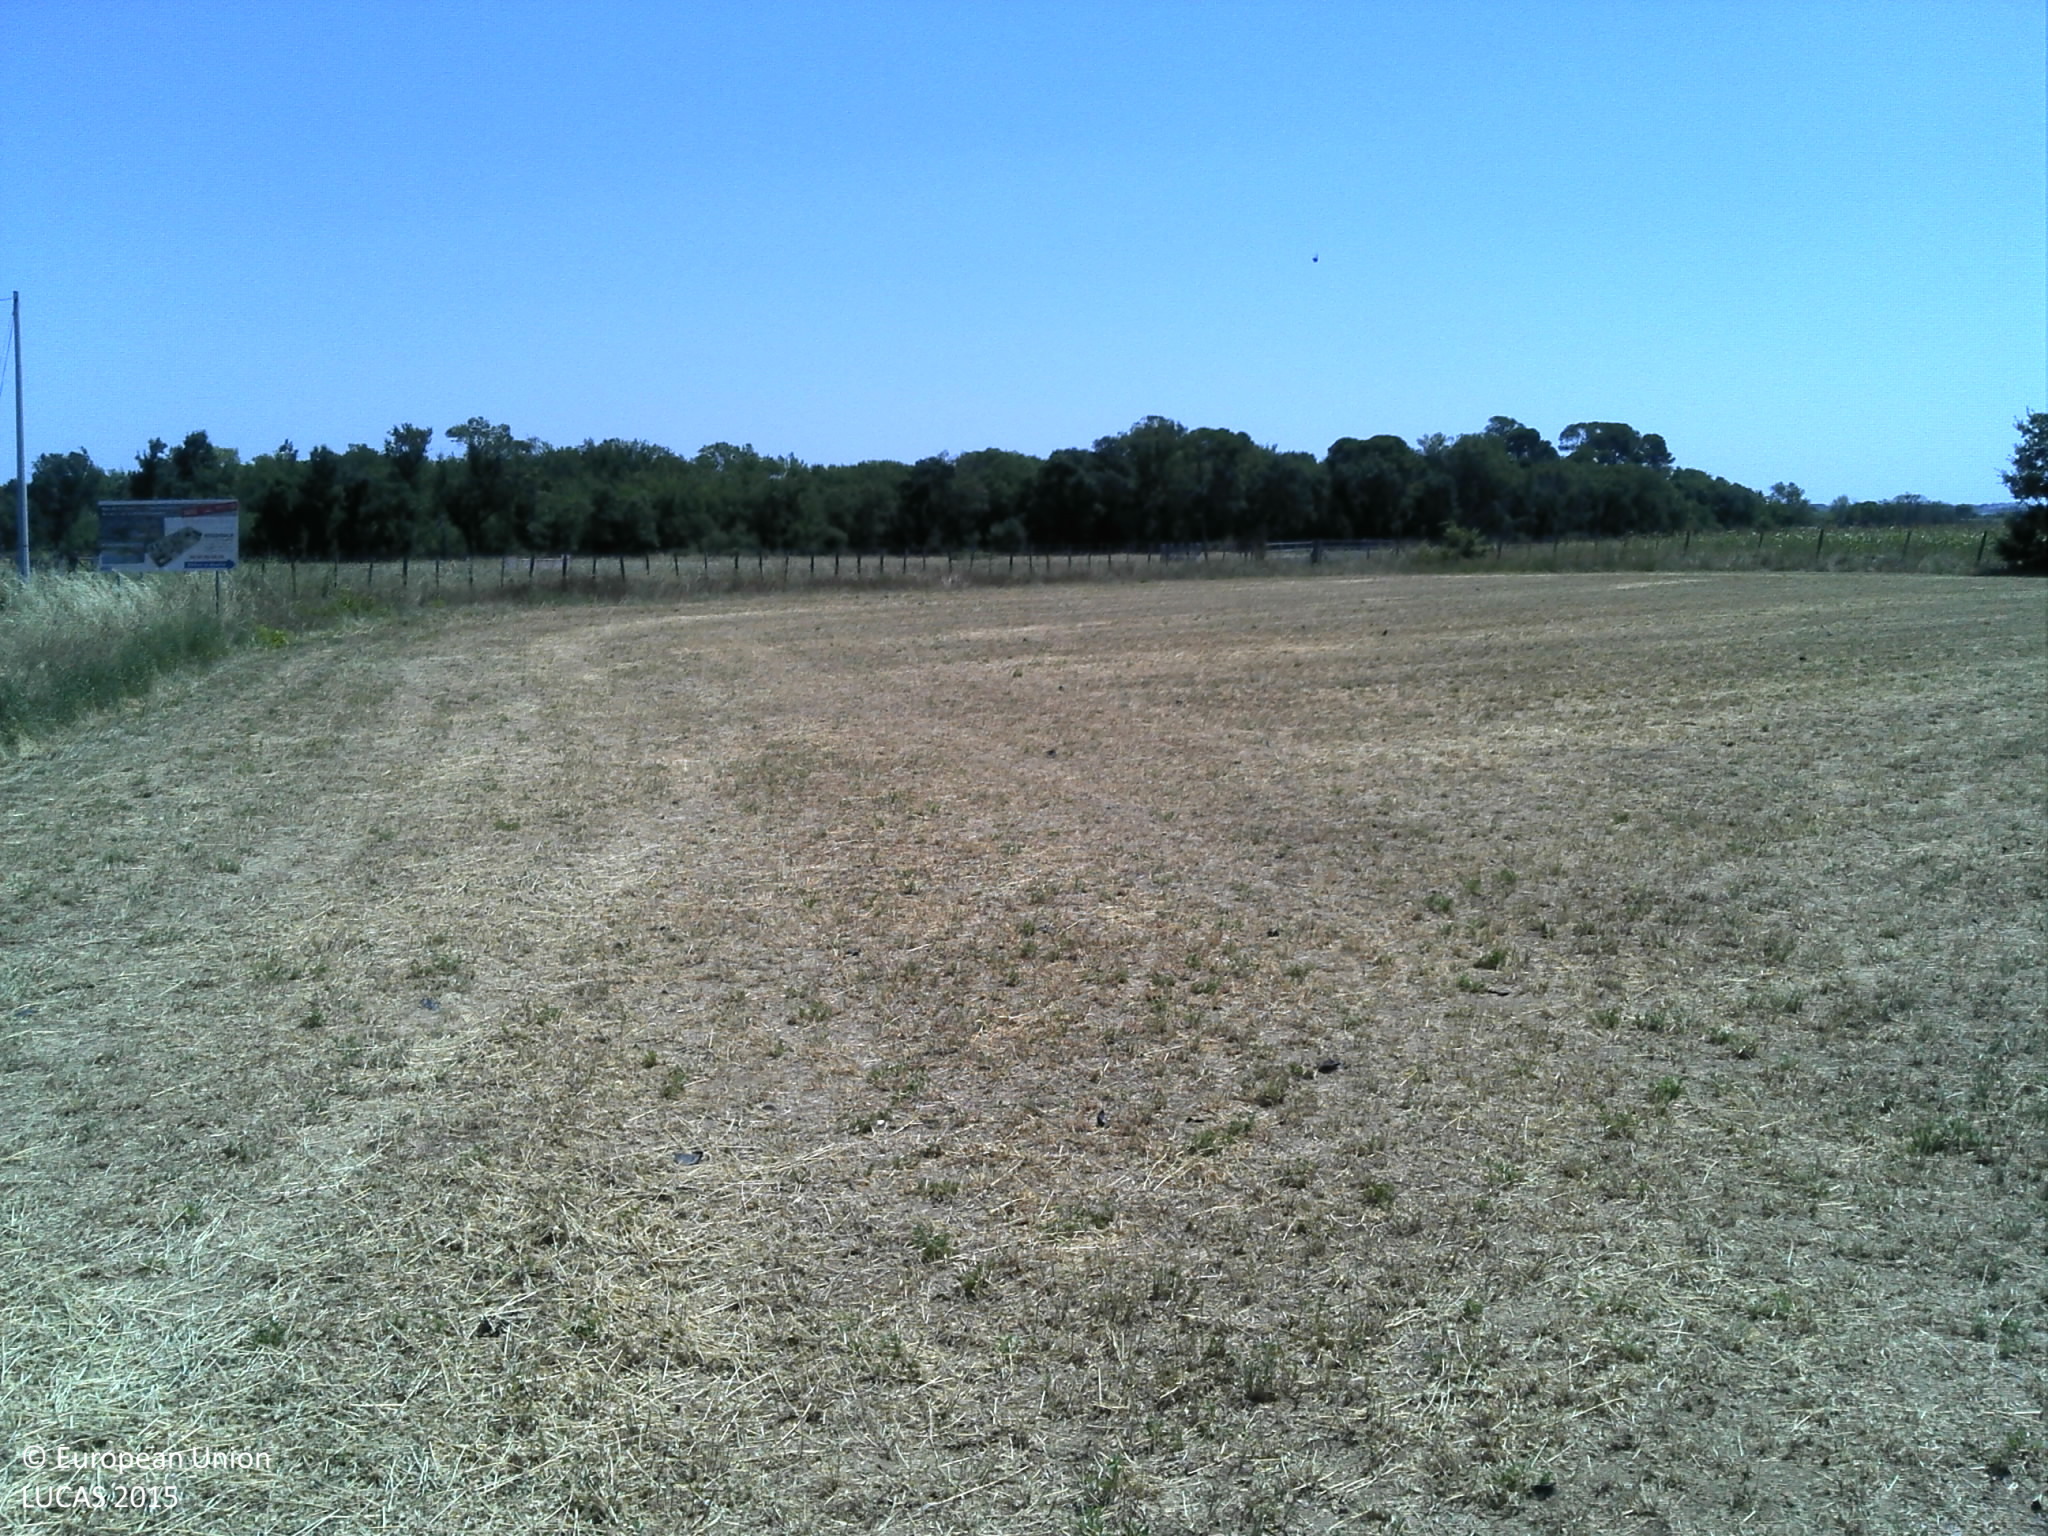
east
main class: Cropland
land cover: Temporary grasslands
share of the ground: > 75 %
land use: Agriculture (excluding fallow land and kitchen gardens)
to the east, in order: Temporary grasslands; Grassland without tree/shrub cover; Fences; Grassland without tree/shrub cover; Fences; Lines of trees; Ditches and canals; Fences; Broadleaved woodland
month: July
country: FR
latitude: 43.5579
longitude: 3.9312
